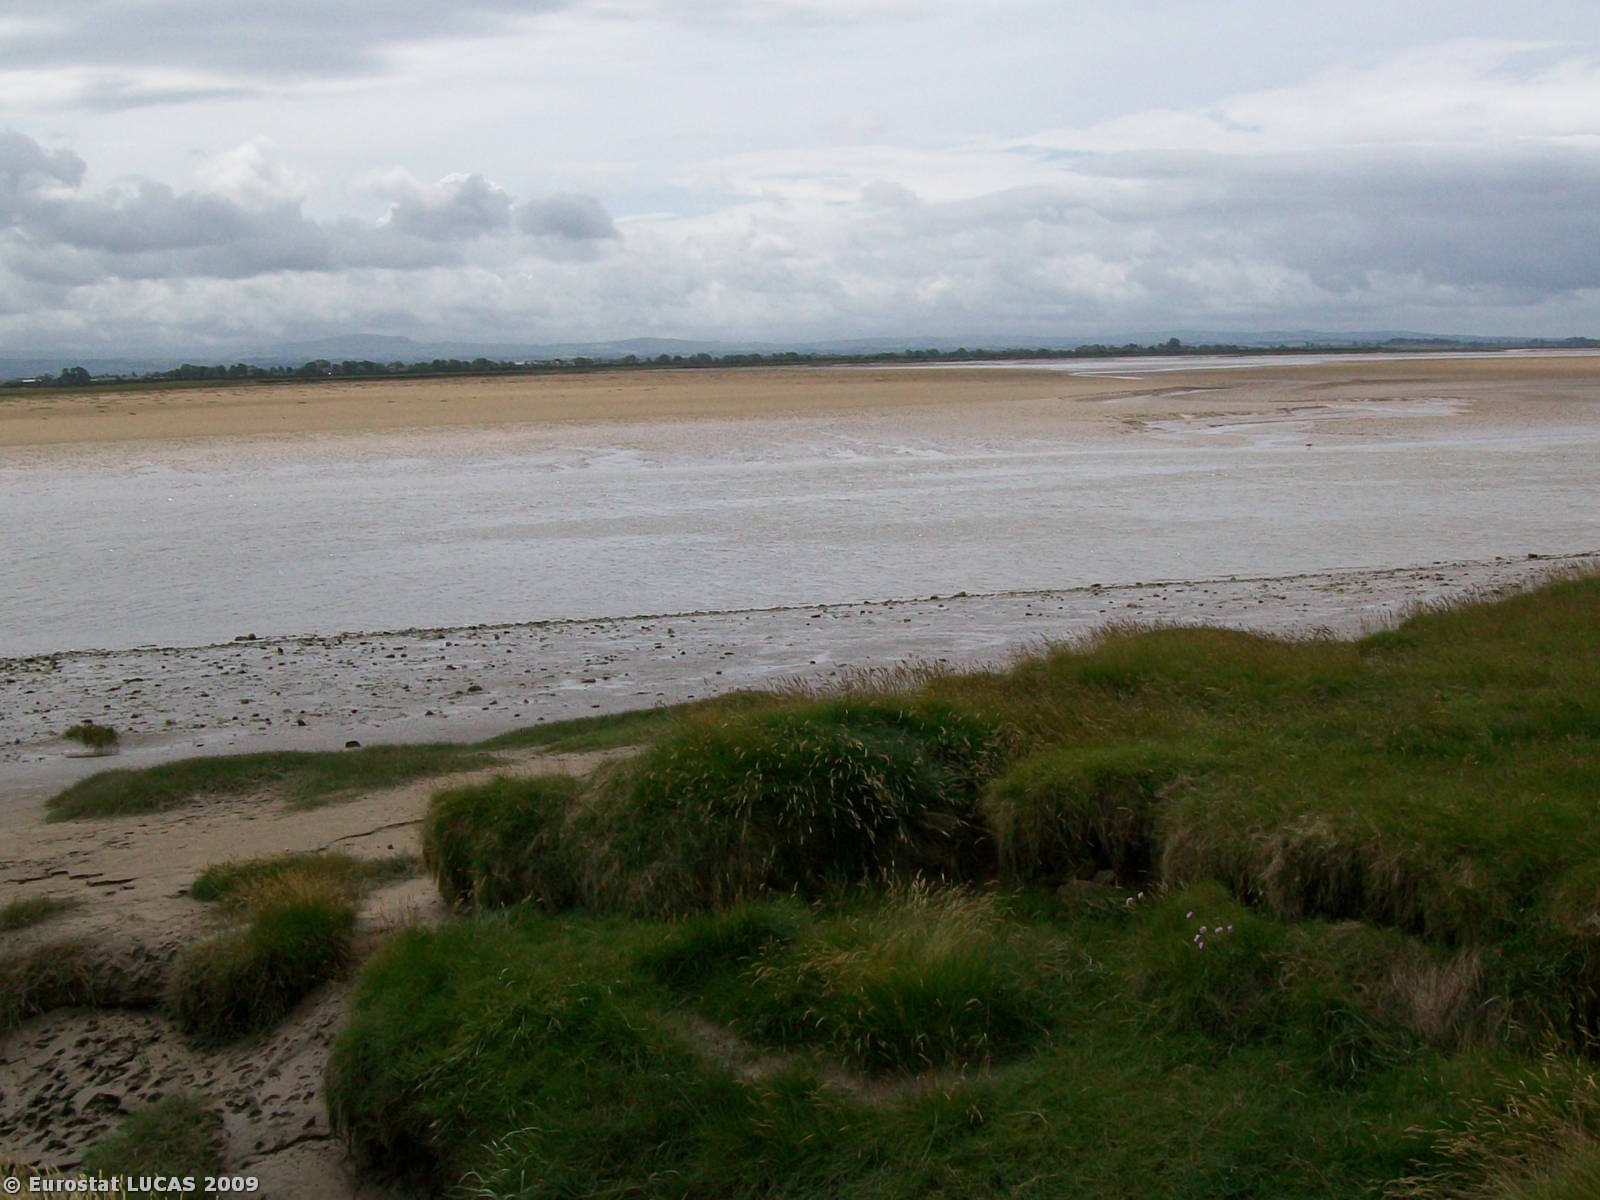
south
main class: Wetlands
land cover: Salt marshes
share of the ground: > 75 %
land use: Unused
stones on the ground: < 10 %
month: June
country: GB
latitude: 54.9120
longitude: -3.2572
